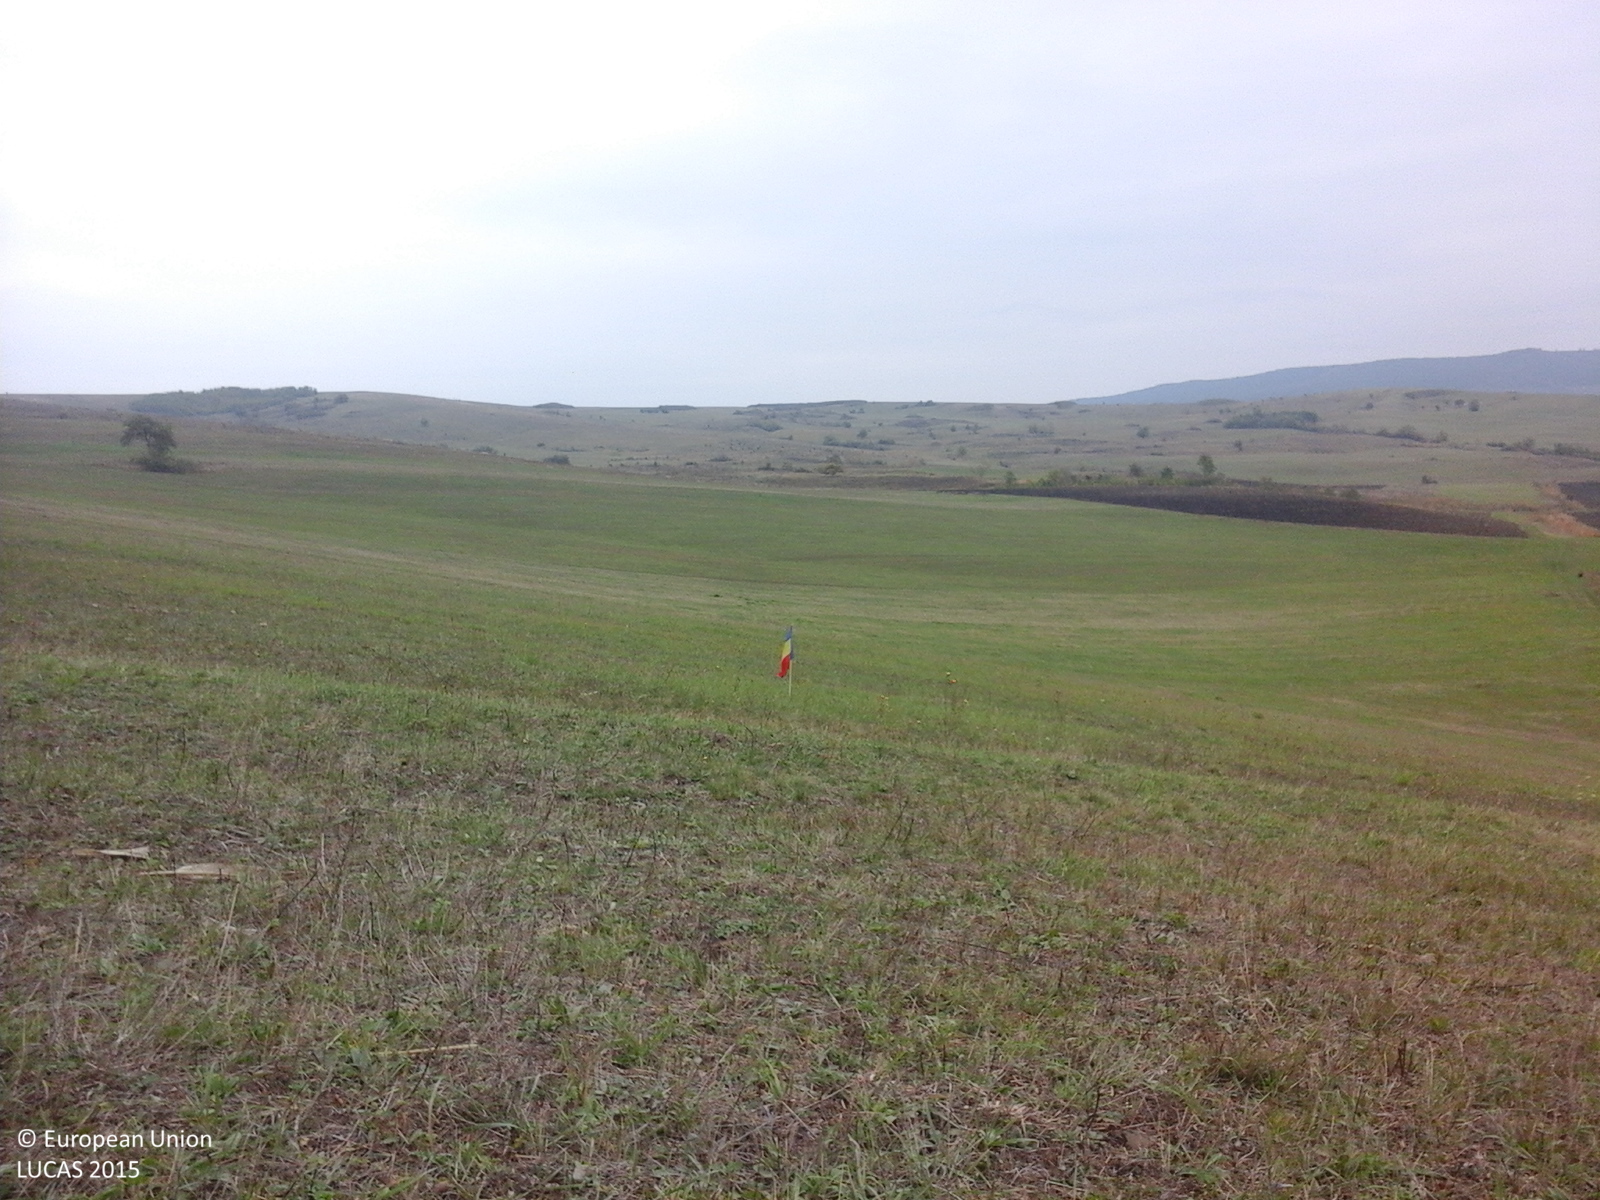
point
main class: Grassland
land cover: Grassland without tree/shrub cover
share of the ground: > 75 %
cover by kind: herbaceous plants 100 %
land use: Agriculture (excluding fallow land and kitchen gardens)
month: October
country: RO
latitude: 46.1104
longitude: 25.2507
